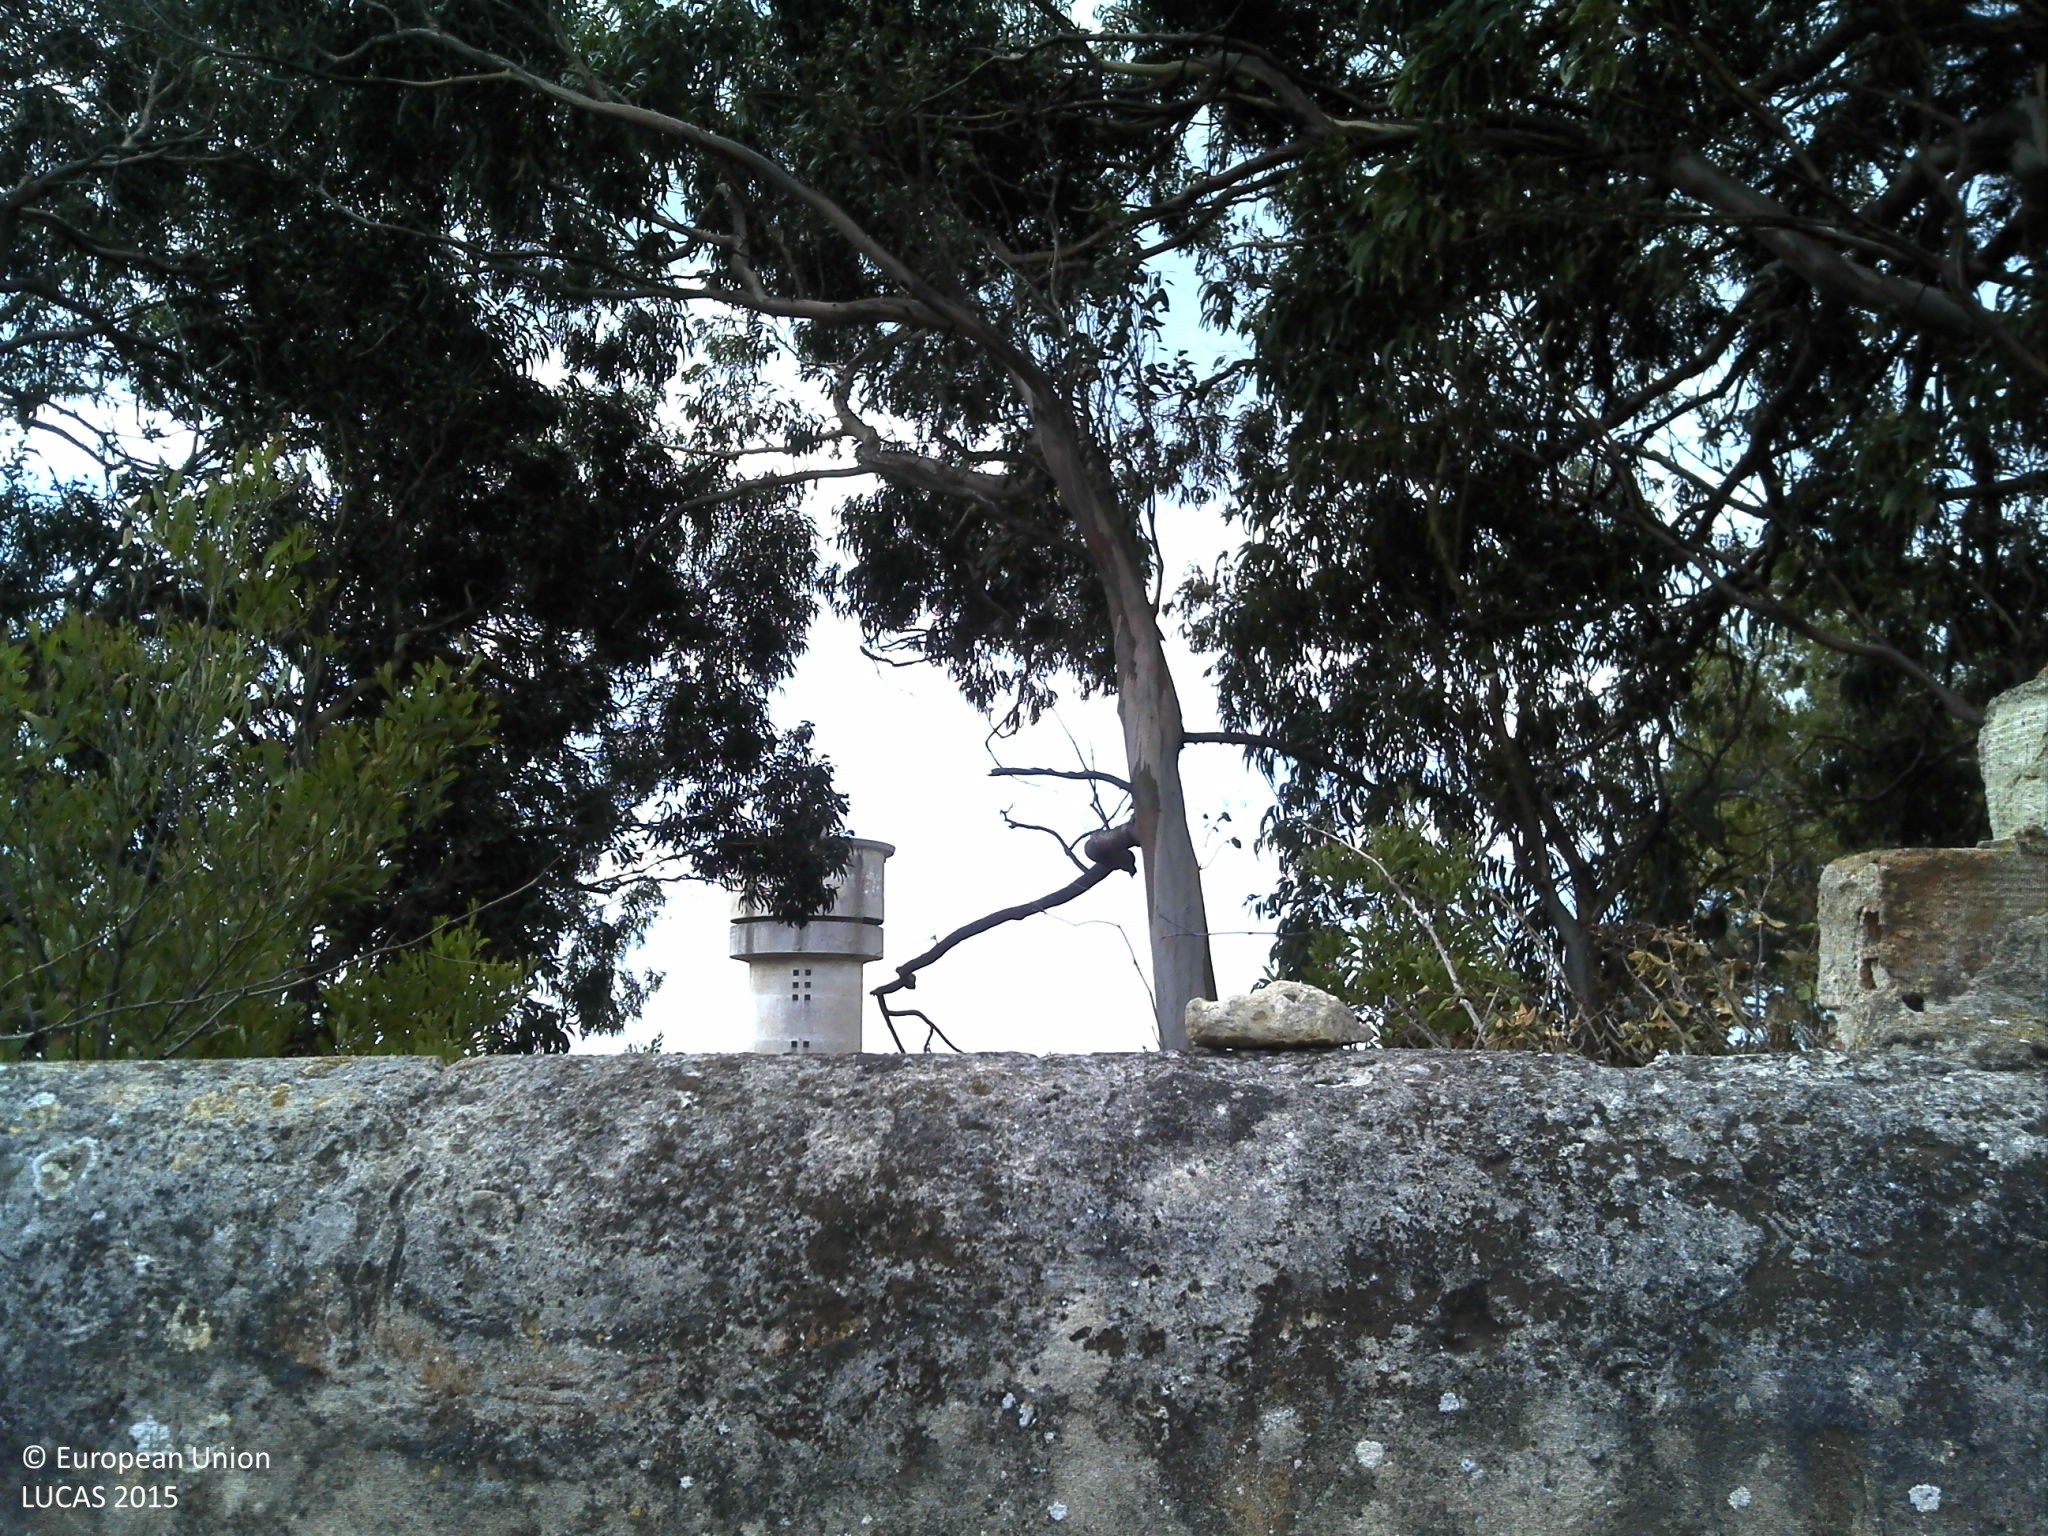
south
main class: Woodland
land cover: Broadleaved woodland
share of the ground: 25 - 50 %
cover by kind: broadleaved forest trees 50 %, unconsolidated bare surface 30 %, shrubs 10 %, herbaceous plants 10 %
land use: Community services
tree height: > 5 m
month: September
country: PT
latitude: 38.7283
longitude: -9.3487
